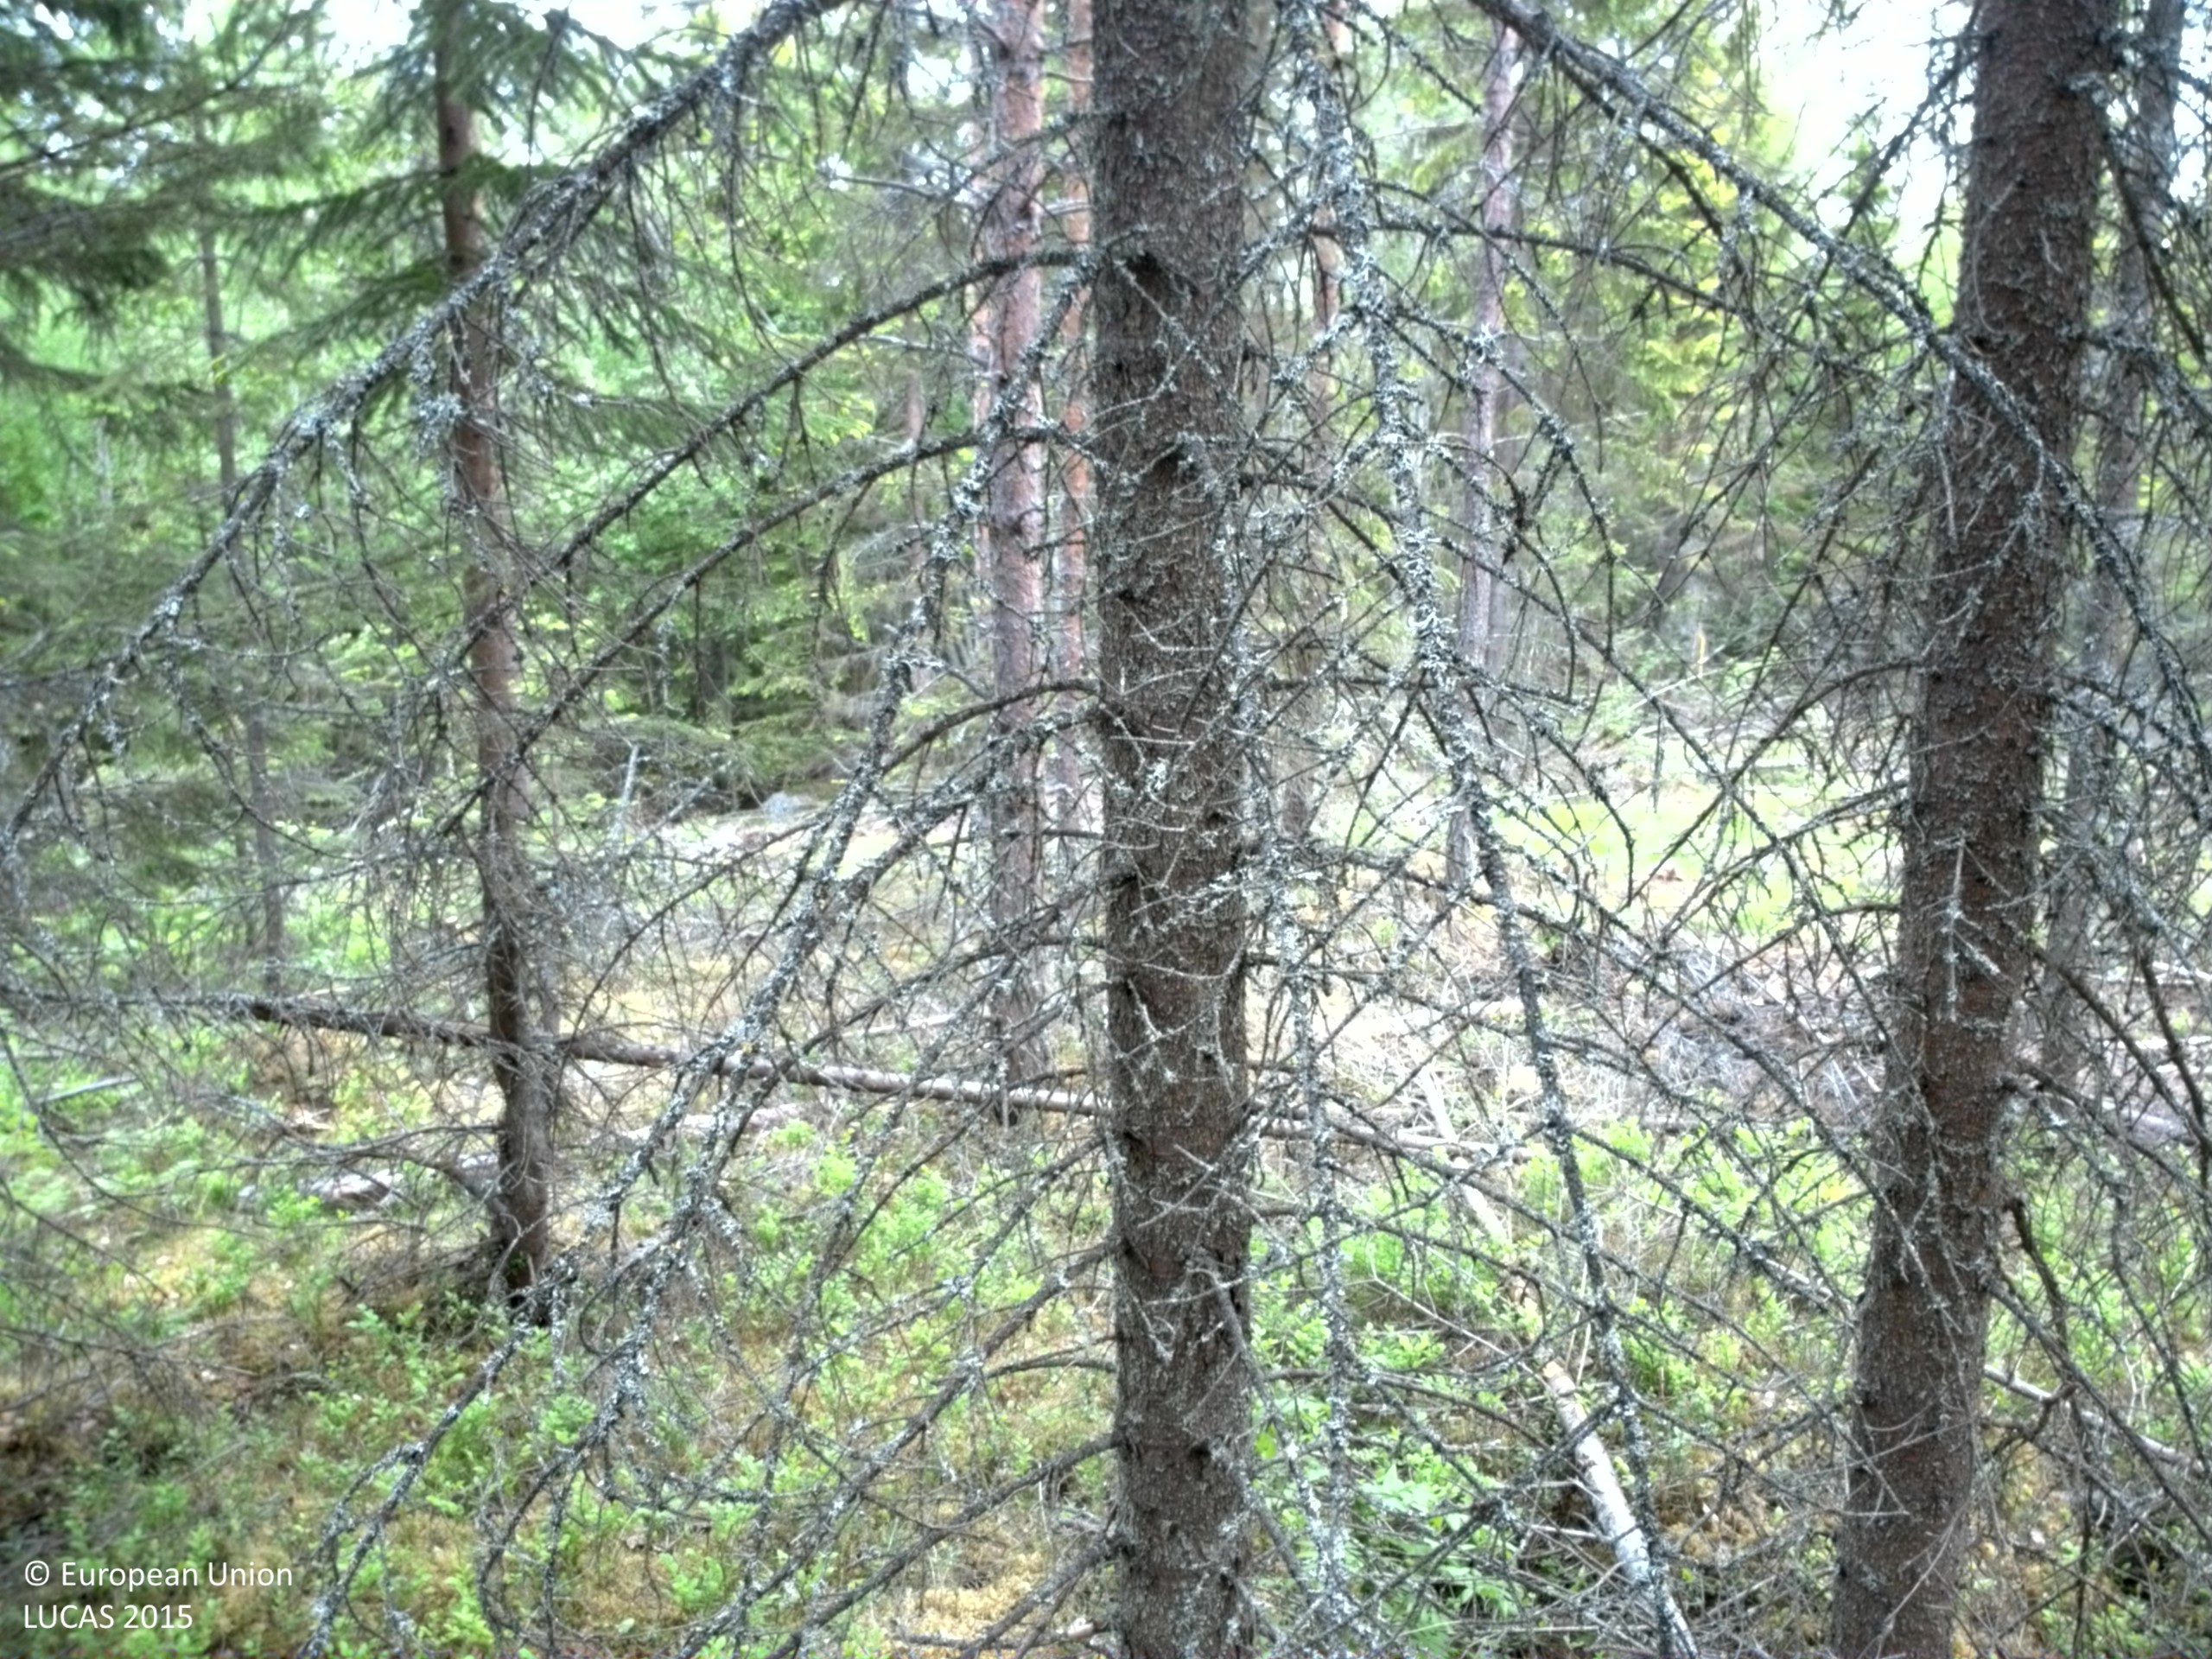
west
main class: Woodland
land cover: Spruce dominated coniferous woodland
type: boreal forest
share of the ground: > 75 %
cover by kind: coniferous forest trees 70 %, shrubs 15 %, broadleaved forest trees 5 %
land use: Forestry
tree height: > 5 m
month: June
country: SE
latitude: 63.1508
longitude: 17.8557
